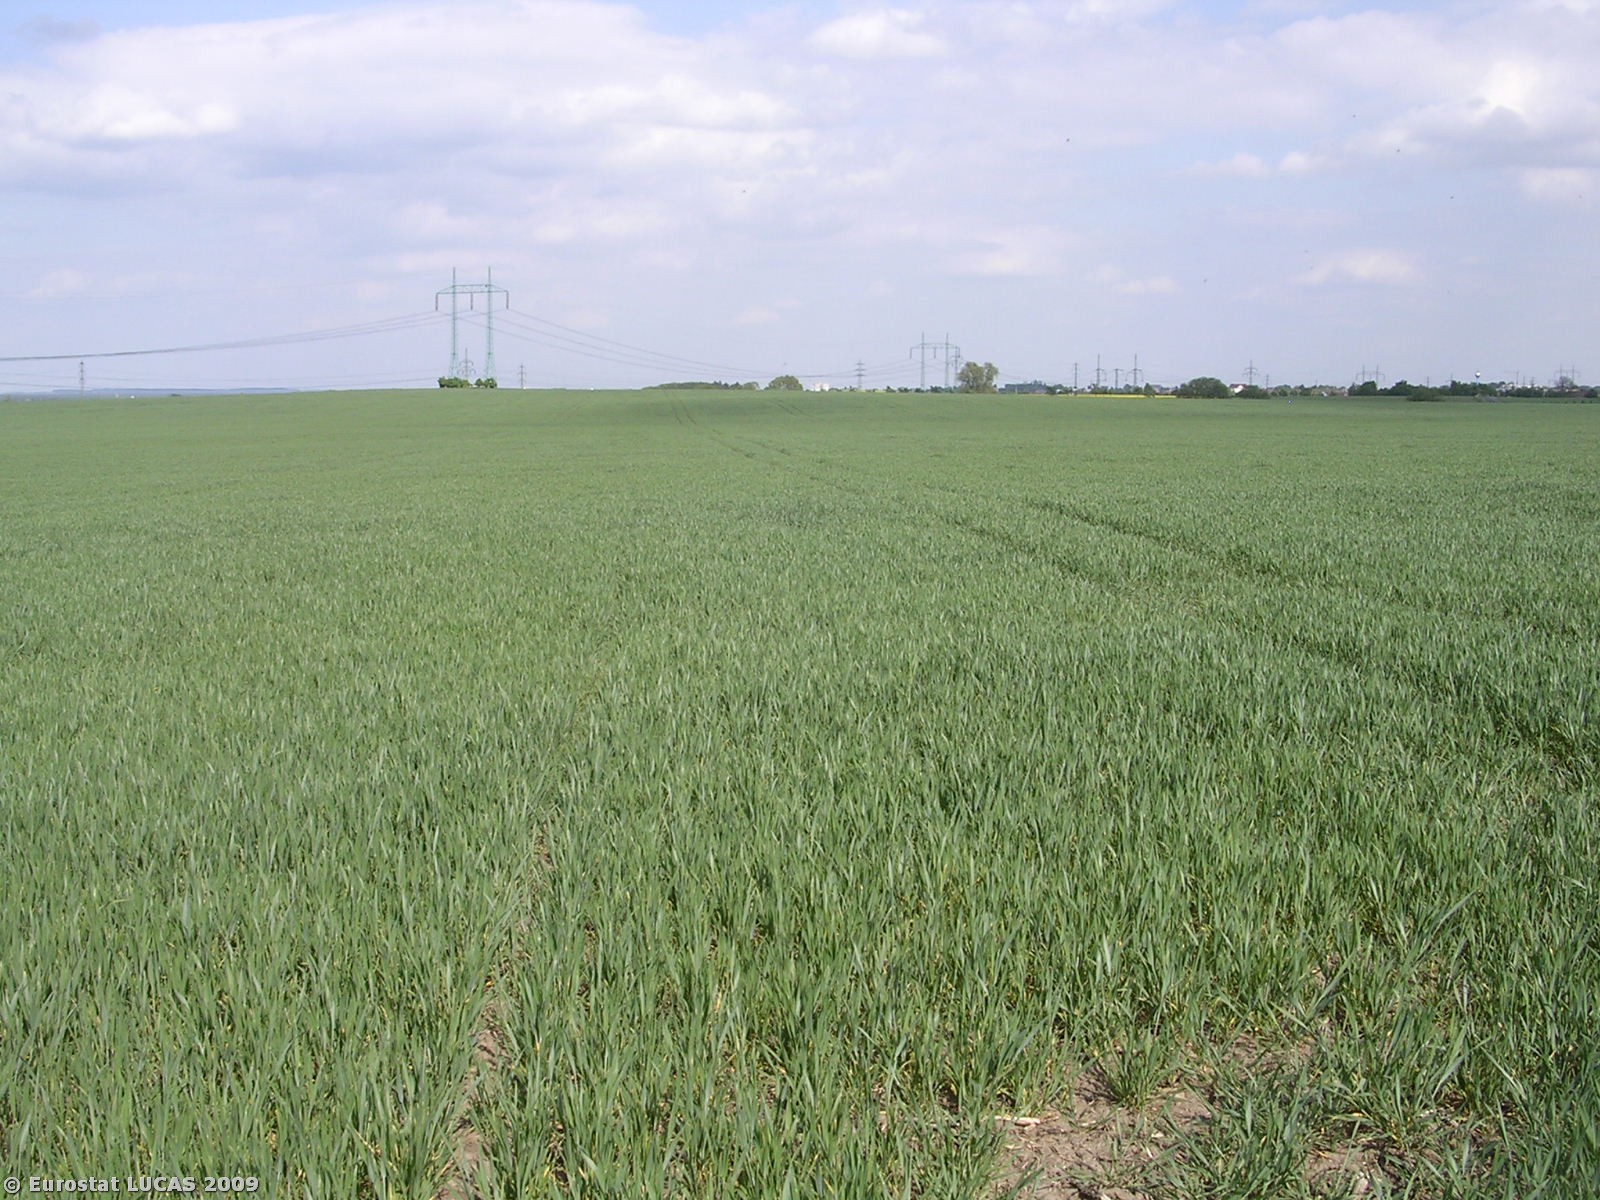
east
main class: Cropland
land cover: Common wheat
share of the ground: > 75 %
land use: Agriculture (excluding fallow land and kitchen gardens)
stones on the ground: < 10 %
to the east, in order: Common wheat
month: May
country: CZ
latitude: 50.1812
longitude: 14.6092
